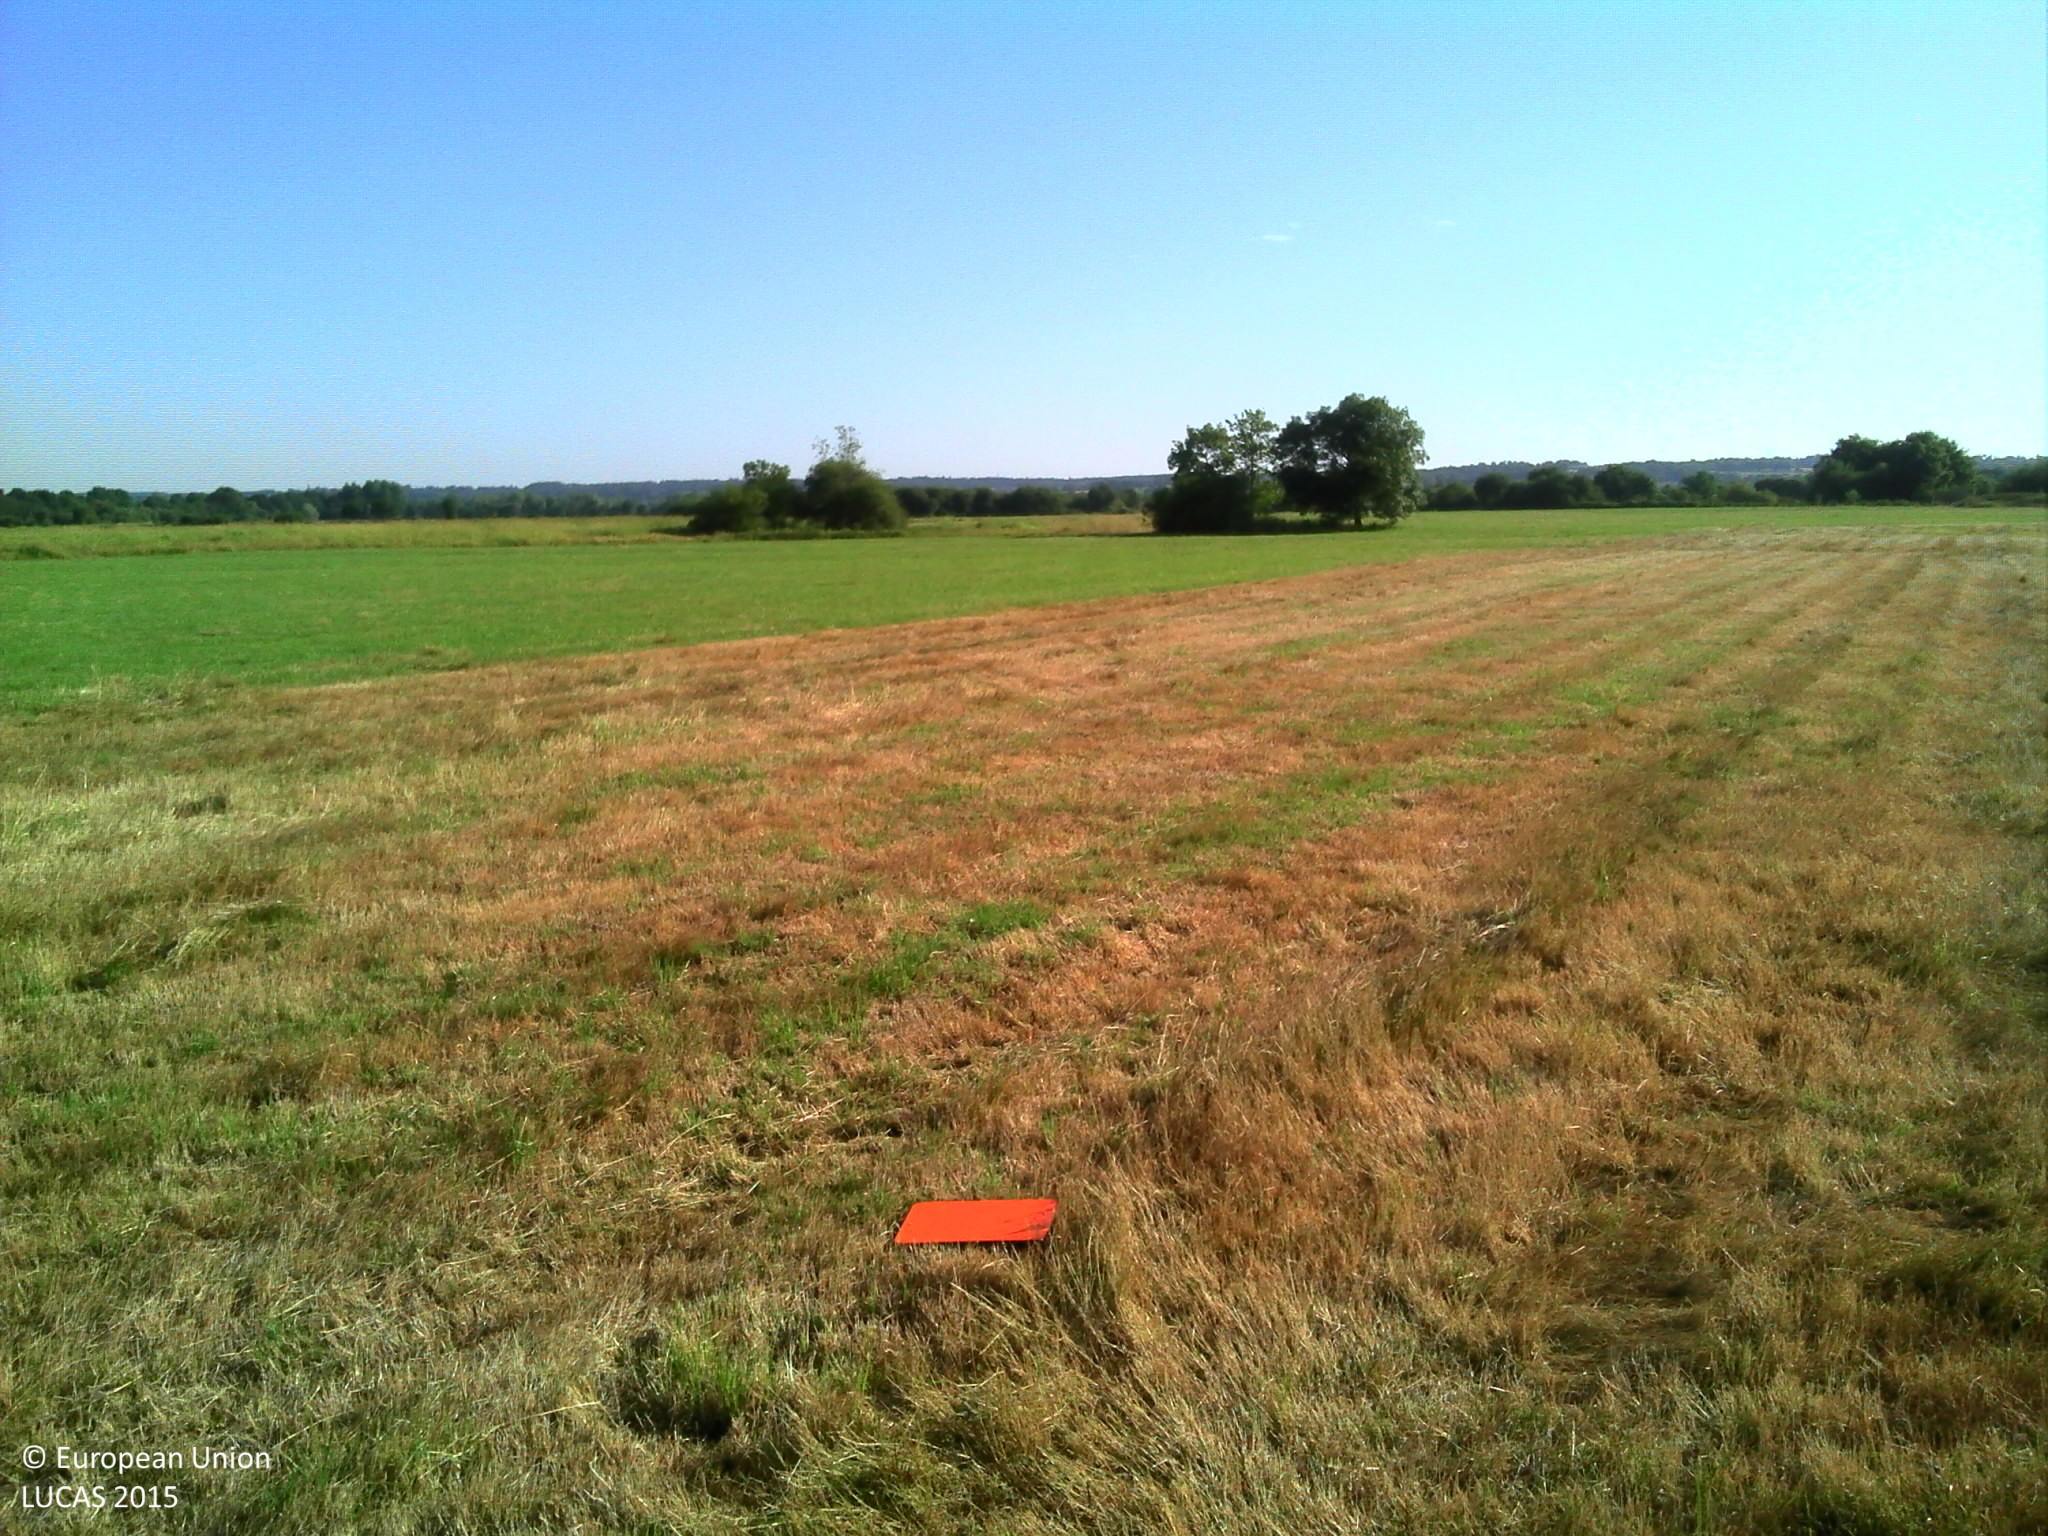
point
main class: Cropland
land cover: Temporary grasslands
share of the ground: > 75 %
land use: Agriculture (excluding fallow land and kitchen gardens)
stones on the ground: < 10 %
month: July
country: FR
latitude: 47.6776
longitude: -1.9715
